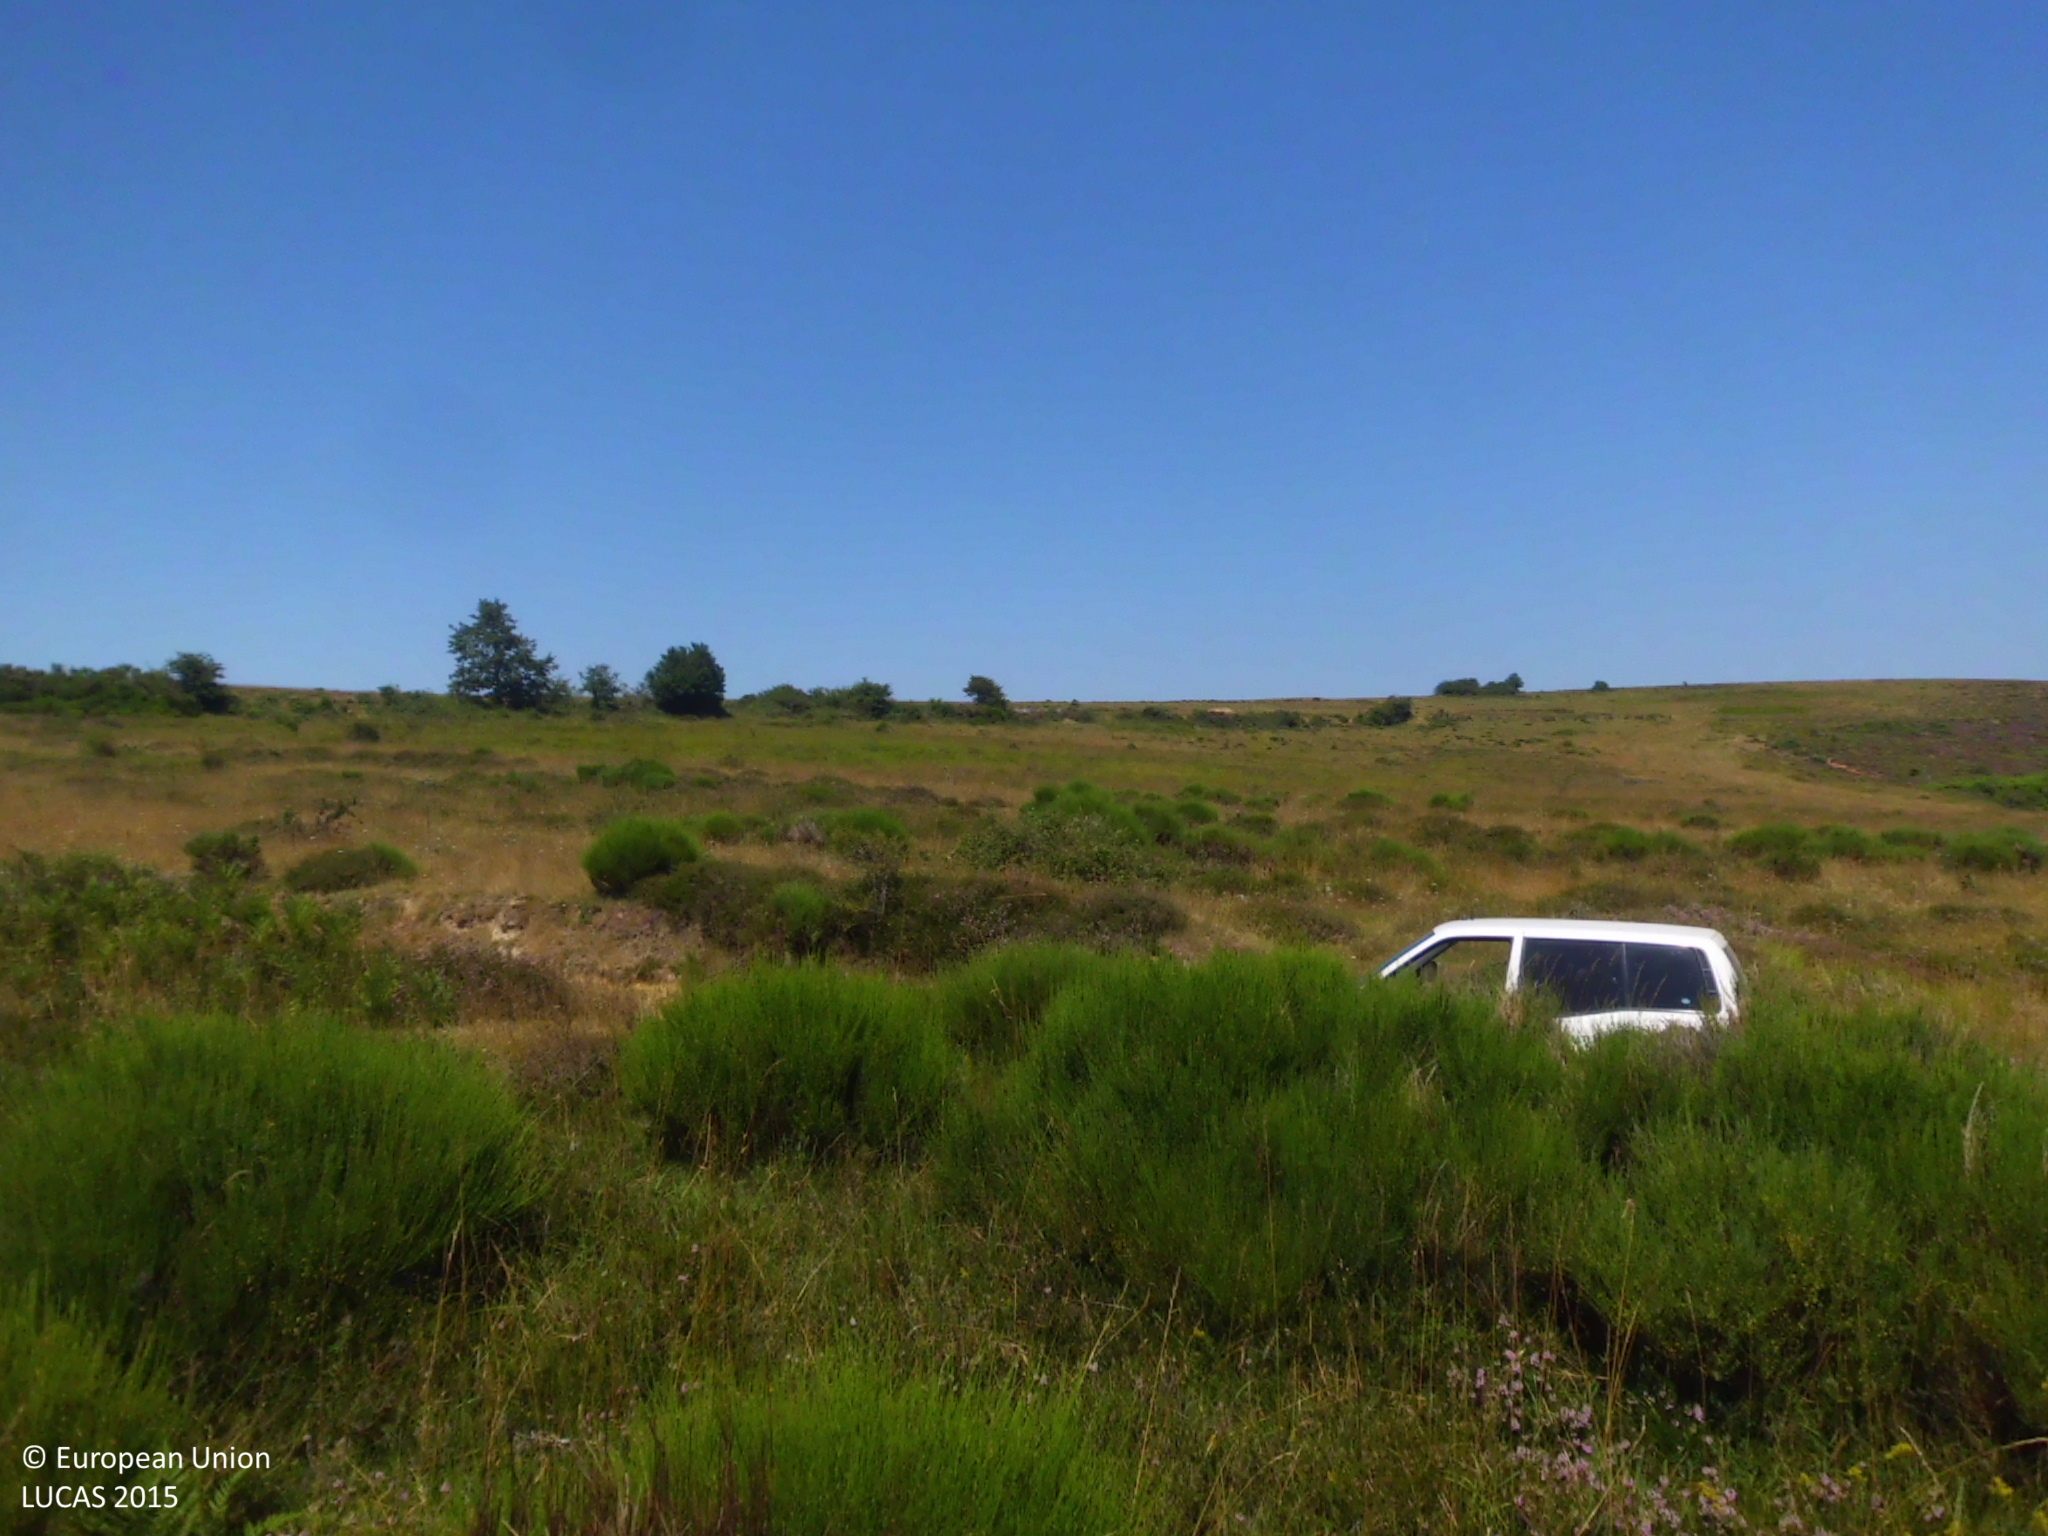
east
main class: Shrubland
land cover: Shrubland without tree cover
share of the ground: 50 - 75 %
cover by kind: shrubs 60 %, herbaceous plants 40 %
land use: Semi-natural and natural areas not in use
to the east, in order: Shrubland without tree cover; Tracks; Shrubland without tree cover
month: July
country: ES
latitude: 42.3251
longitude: -3.2688
